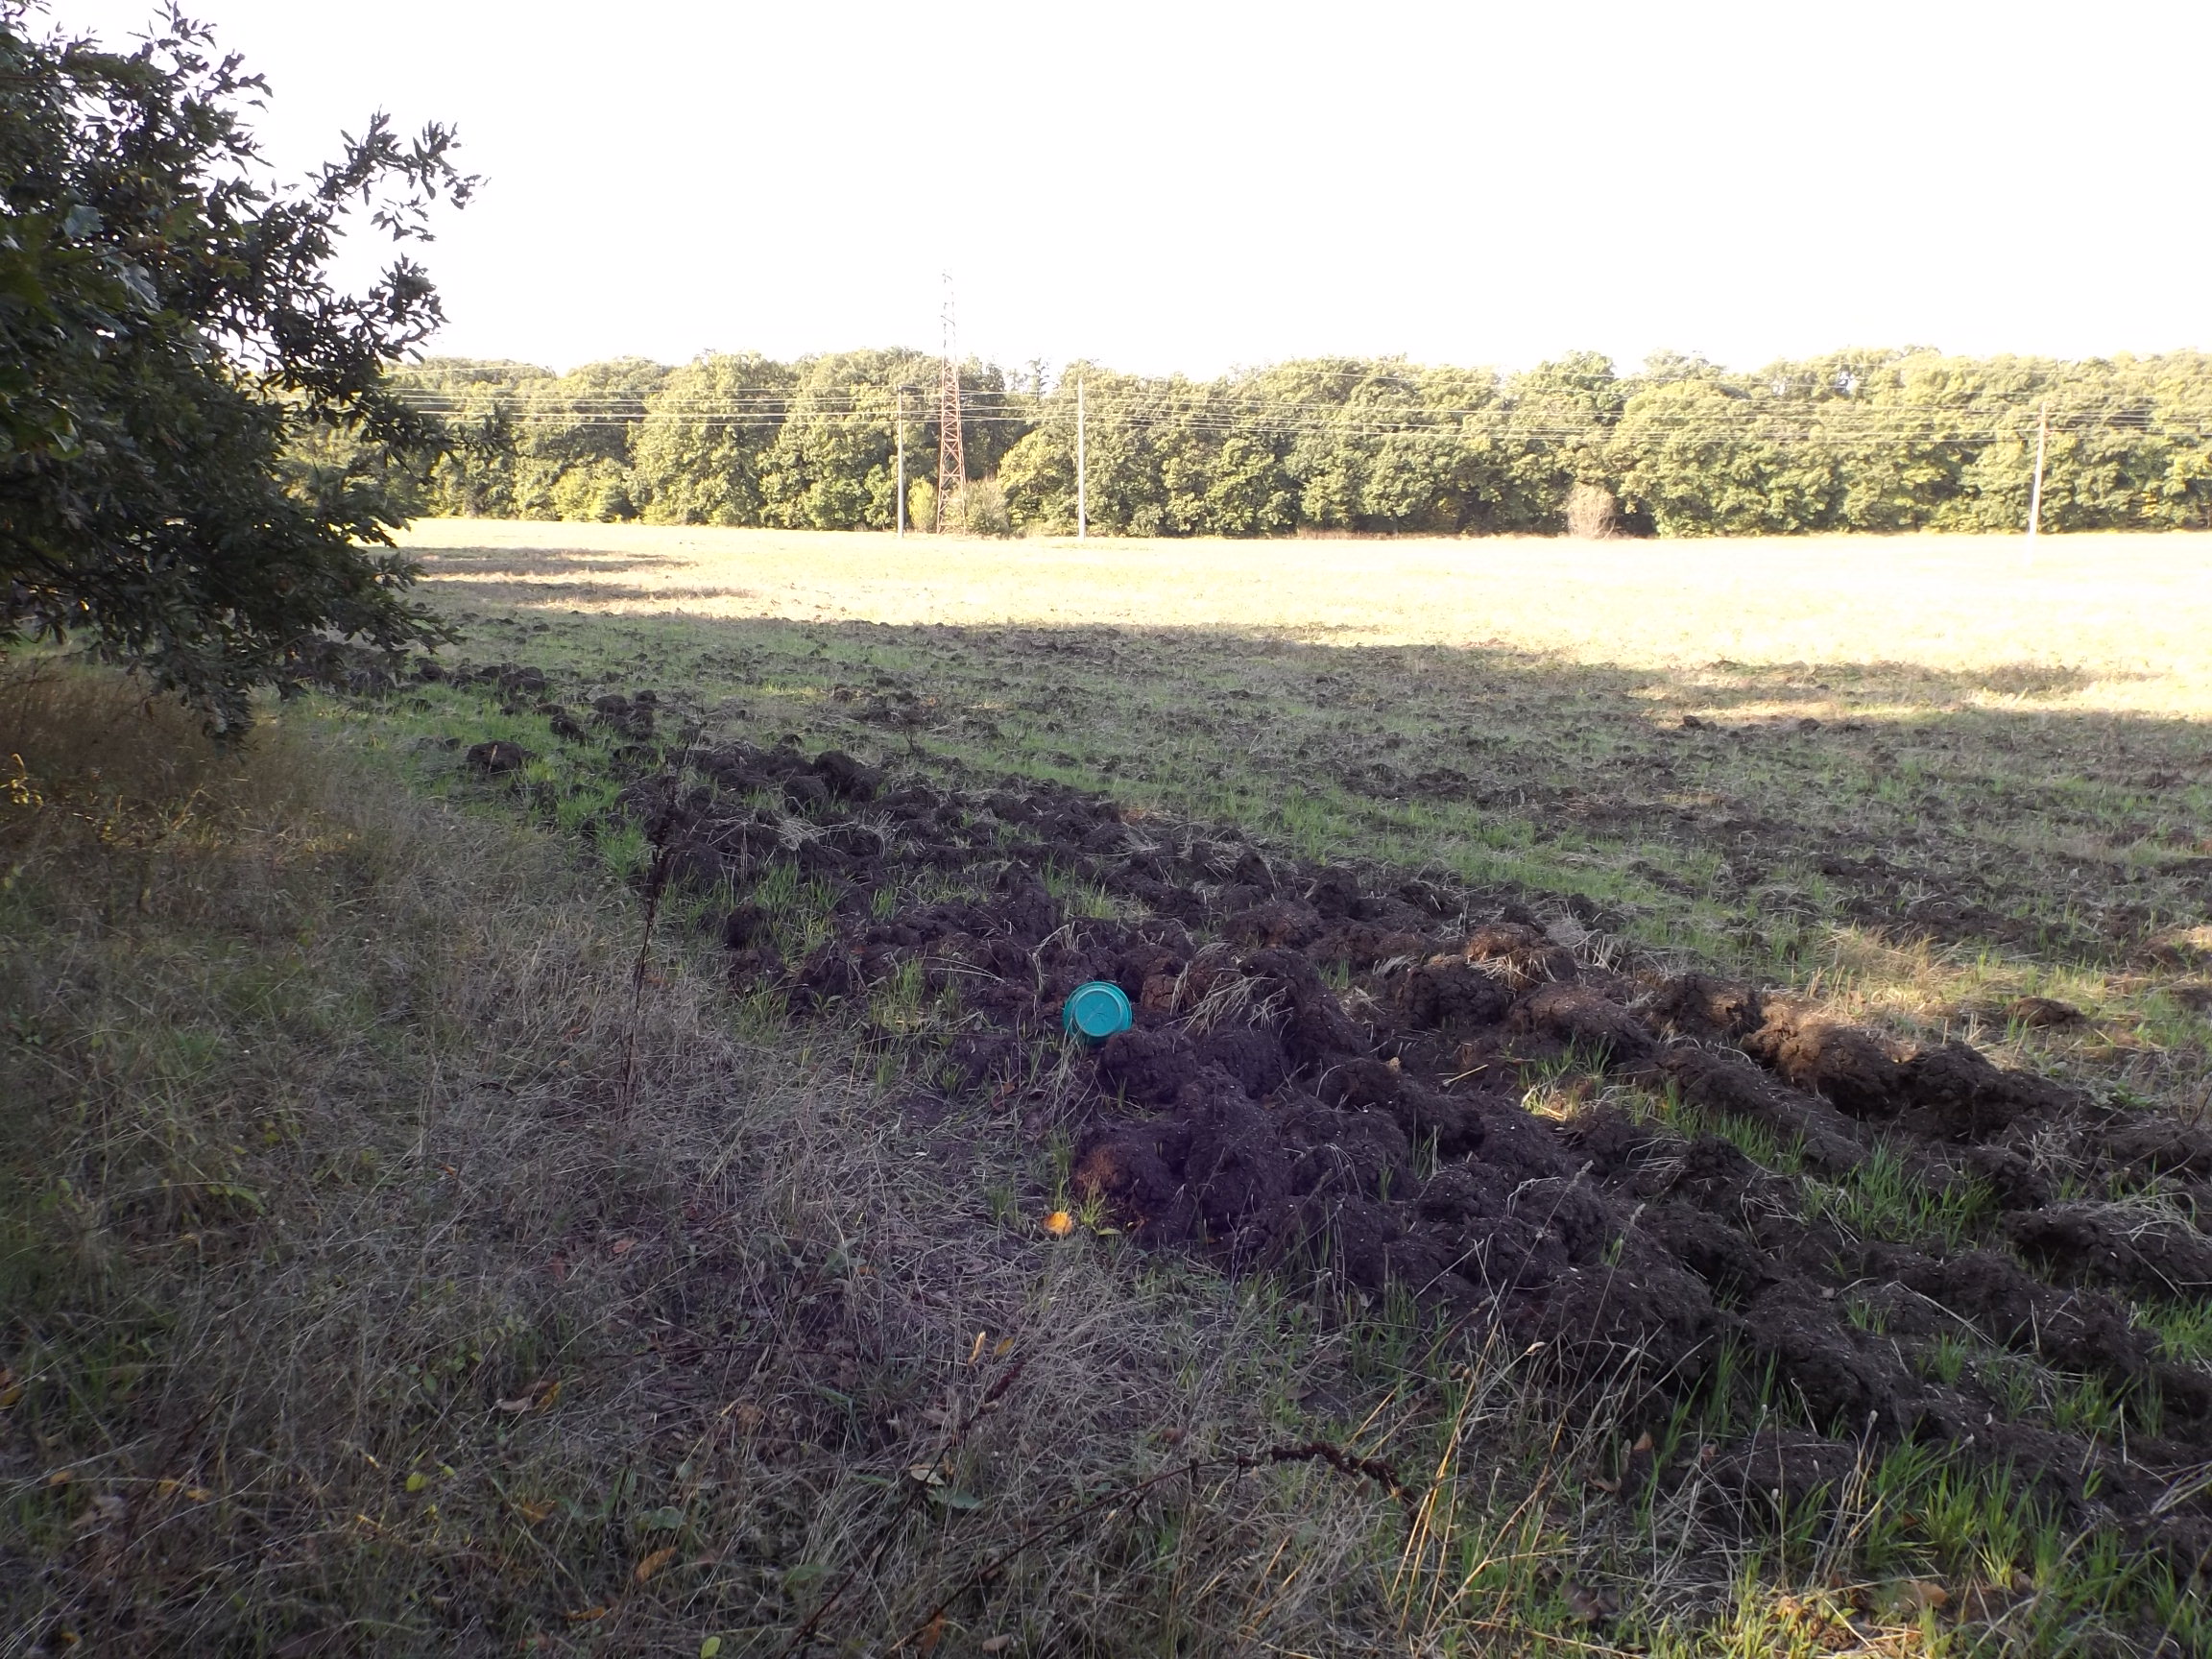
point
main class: Cropland
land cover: Barley
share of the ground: < 10 %
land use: Agriculture (excluding fallow land and kitchen gardens)
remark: Harvested field
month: October
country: BG
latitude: 42.9191
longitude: 27.8352
